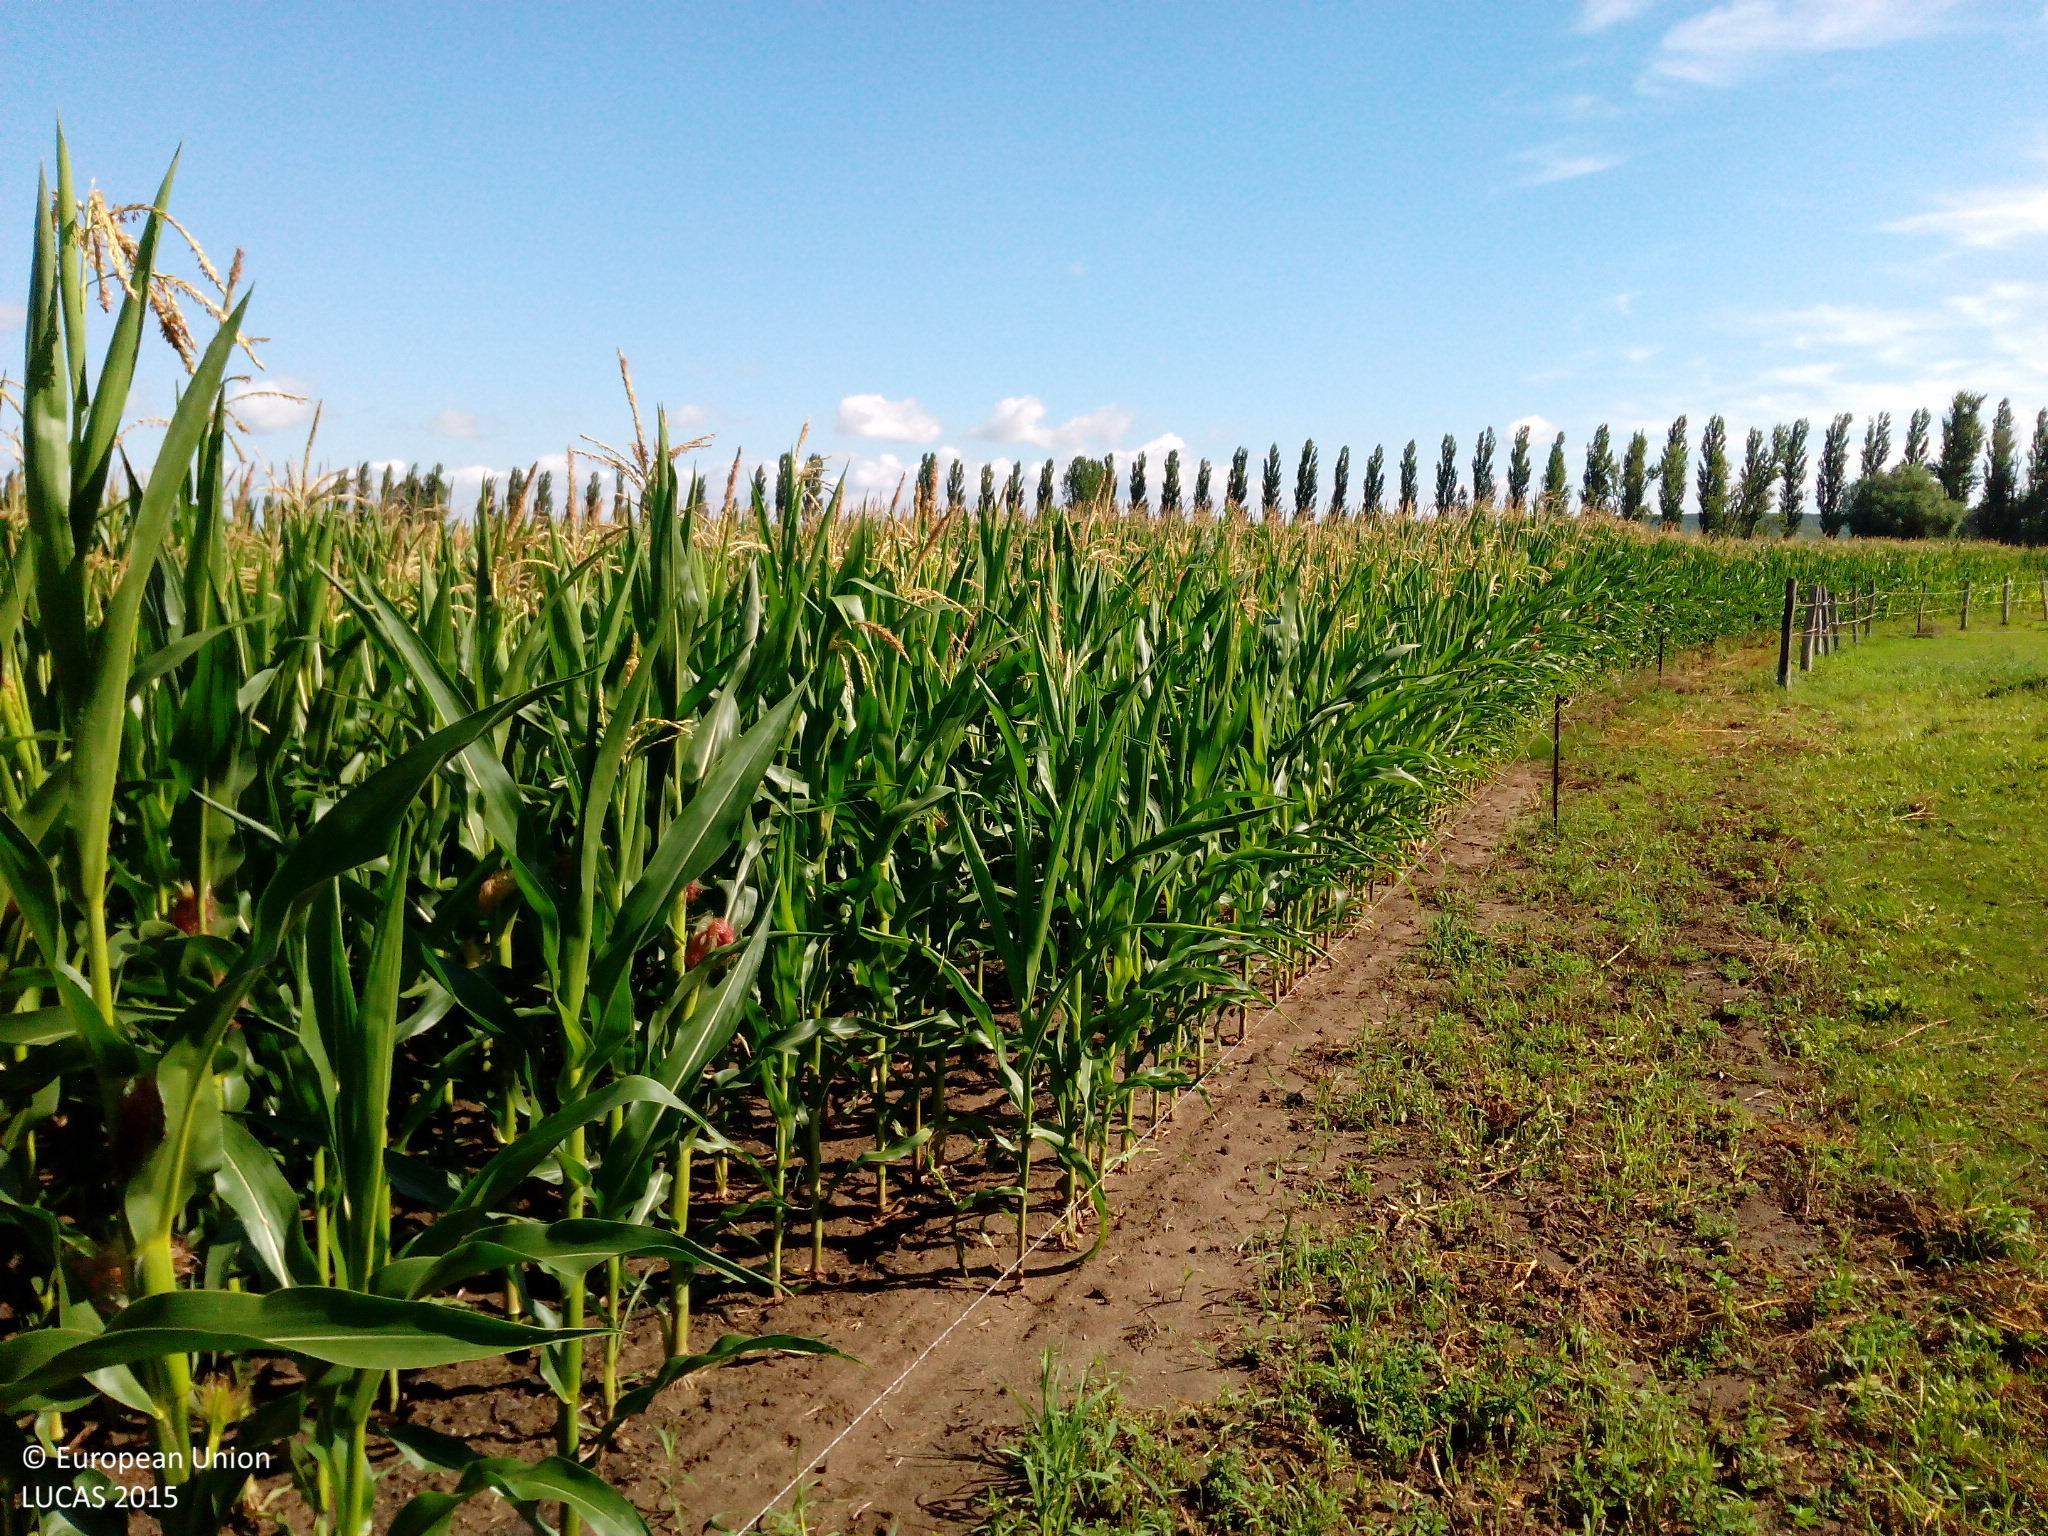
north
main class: Cropland
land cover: Maize
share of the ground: > 75 %
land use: Agriculture (excluding fallow land and kitchen gardens)
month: July
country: DE
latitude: 52.7882
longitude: 14.2270
